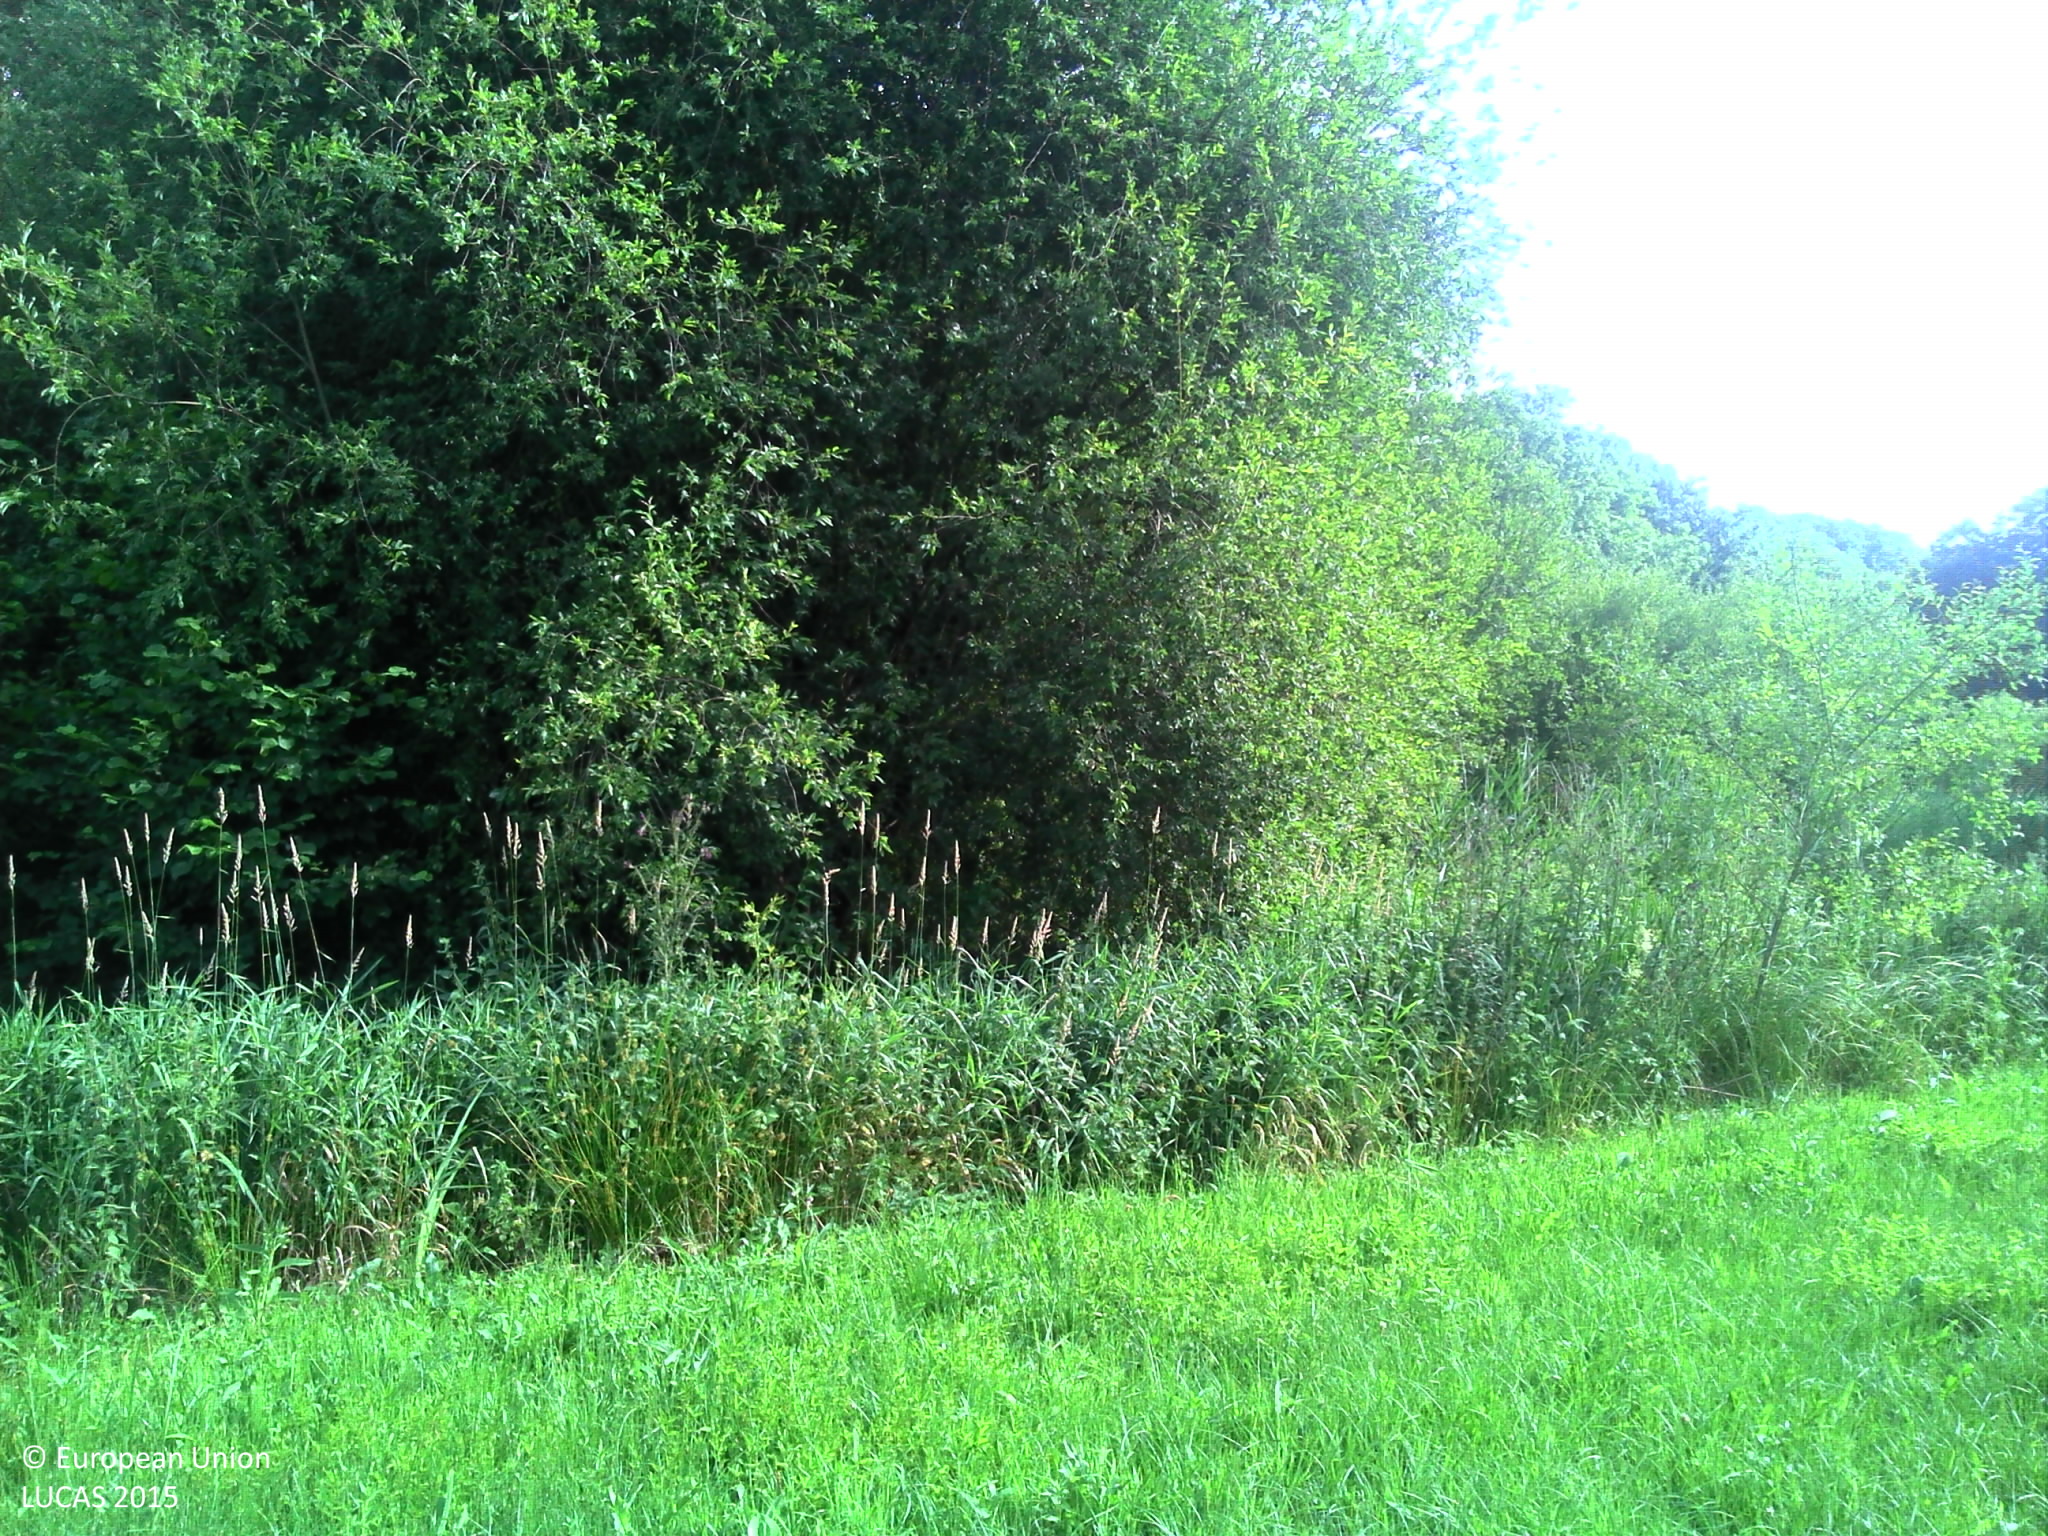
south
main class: Grassland
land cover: Grassland without tree/shrub cover
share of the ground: > 75 %
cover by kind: herbaceous plants 100 %
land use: Agriculture (excluding fallow land and kitchen gardens)
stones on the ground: < 10 %
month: July
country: FR
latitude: 49.3999
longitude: 0.4233
